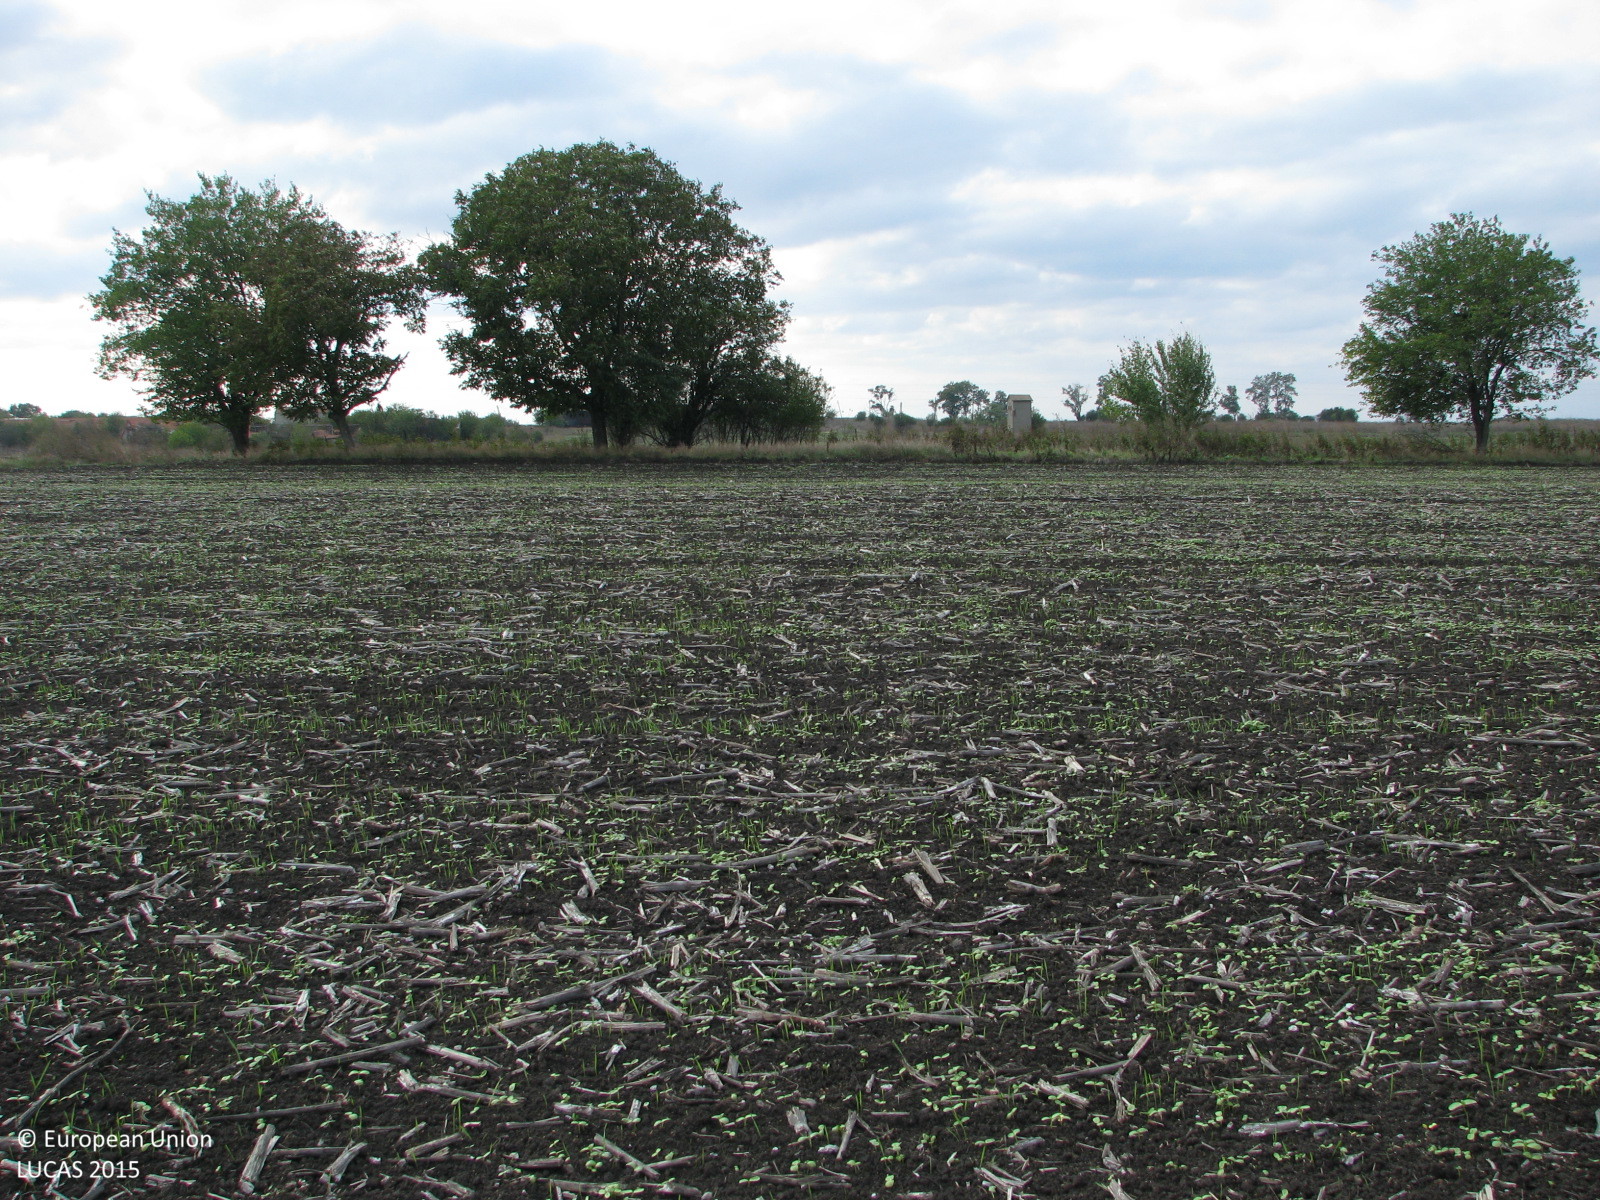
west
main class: Cropland
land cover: Sunflower
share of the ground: < 10 %
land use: Agriculture (excluding fallow land and kitchen gardens)
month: October
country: BG
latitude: 42.2892
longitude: 26.1261
